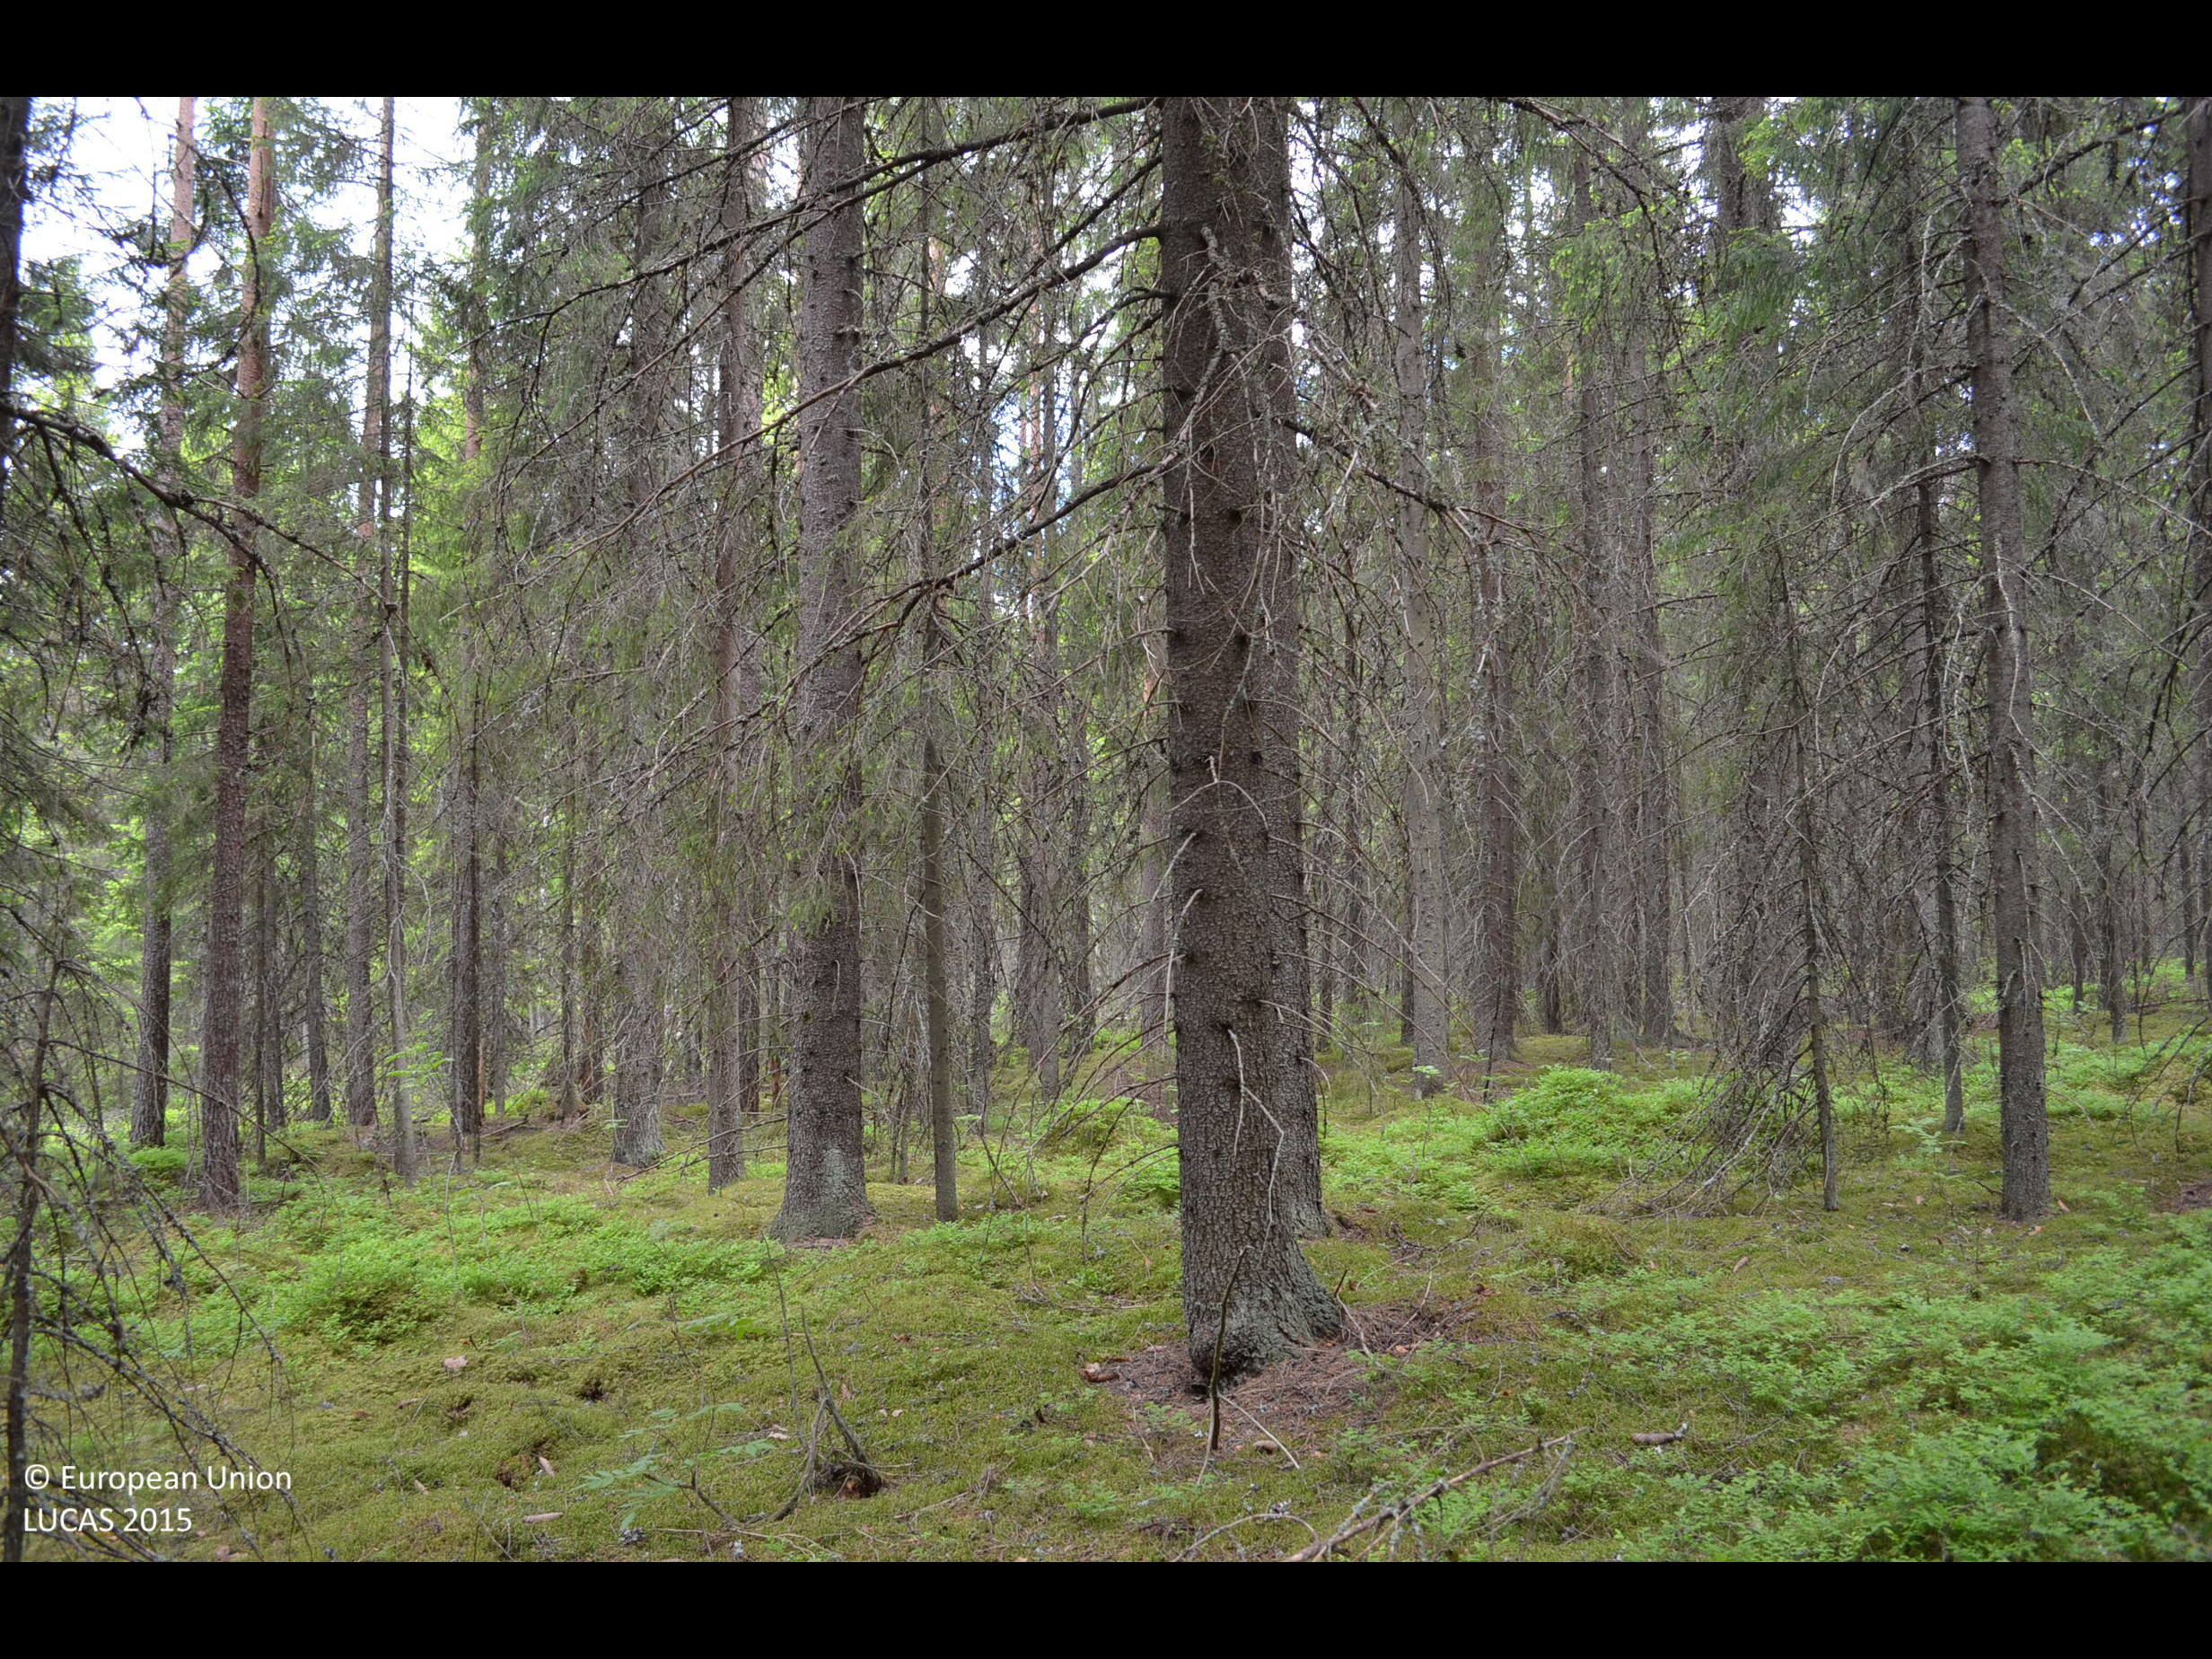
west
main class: Woodland
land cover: Spruce dominated coniferous woodland
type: boreal forest
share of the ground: > 75 %
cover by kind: coniferous forest trees 75 %, shrubs 15 %, broadleaved forest trees 5 %, lichens and mosses 5 %
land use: Forestry
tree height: > 5 m
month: June
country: FI
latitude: 61.9548
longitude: 23.4008
